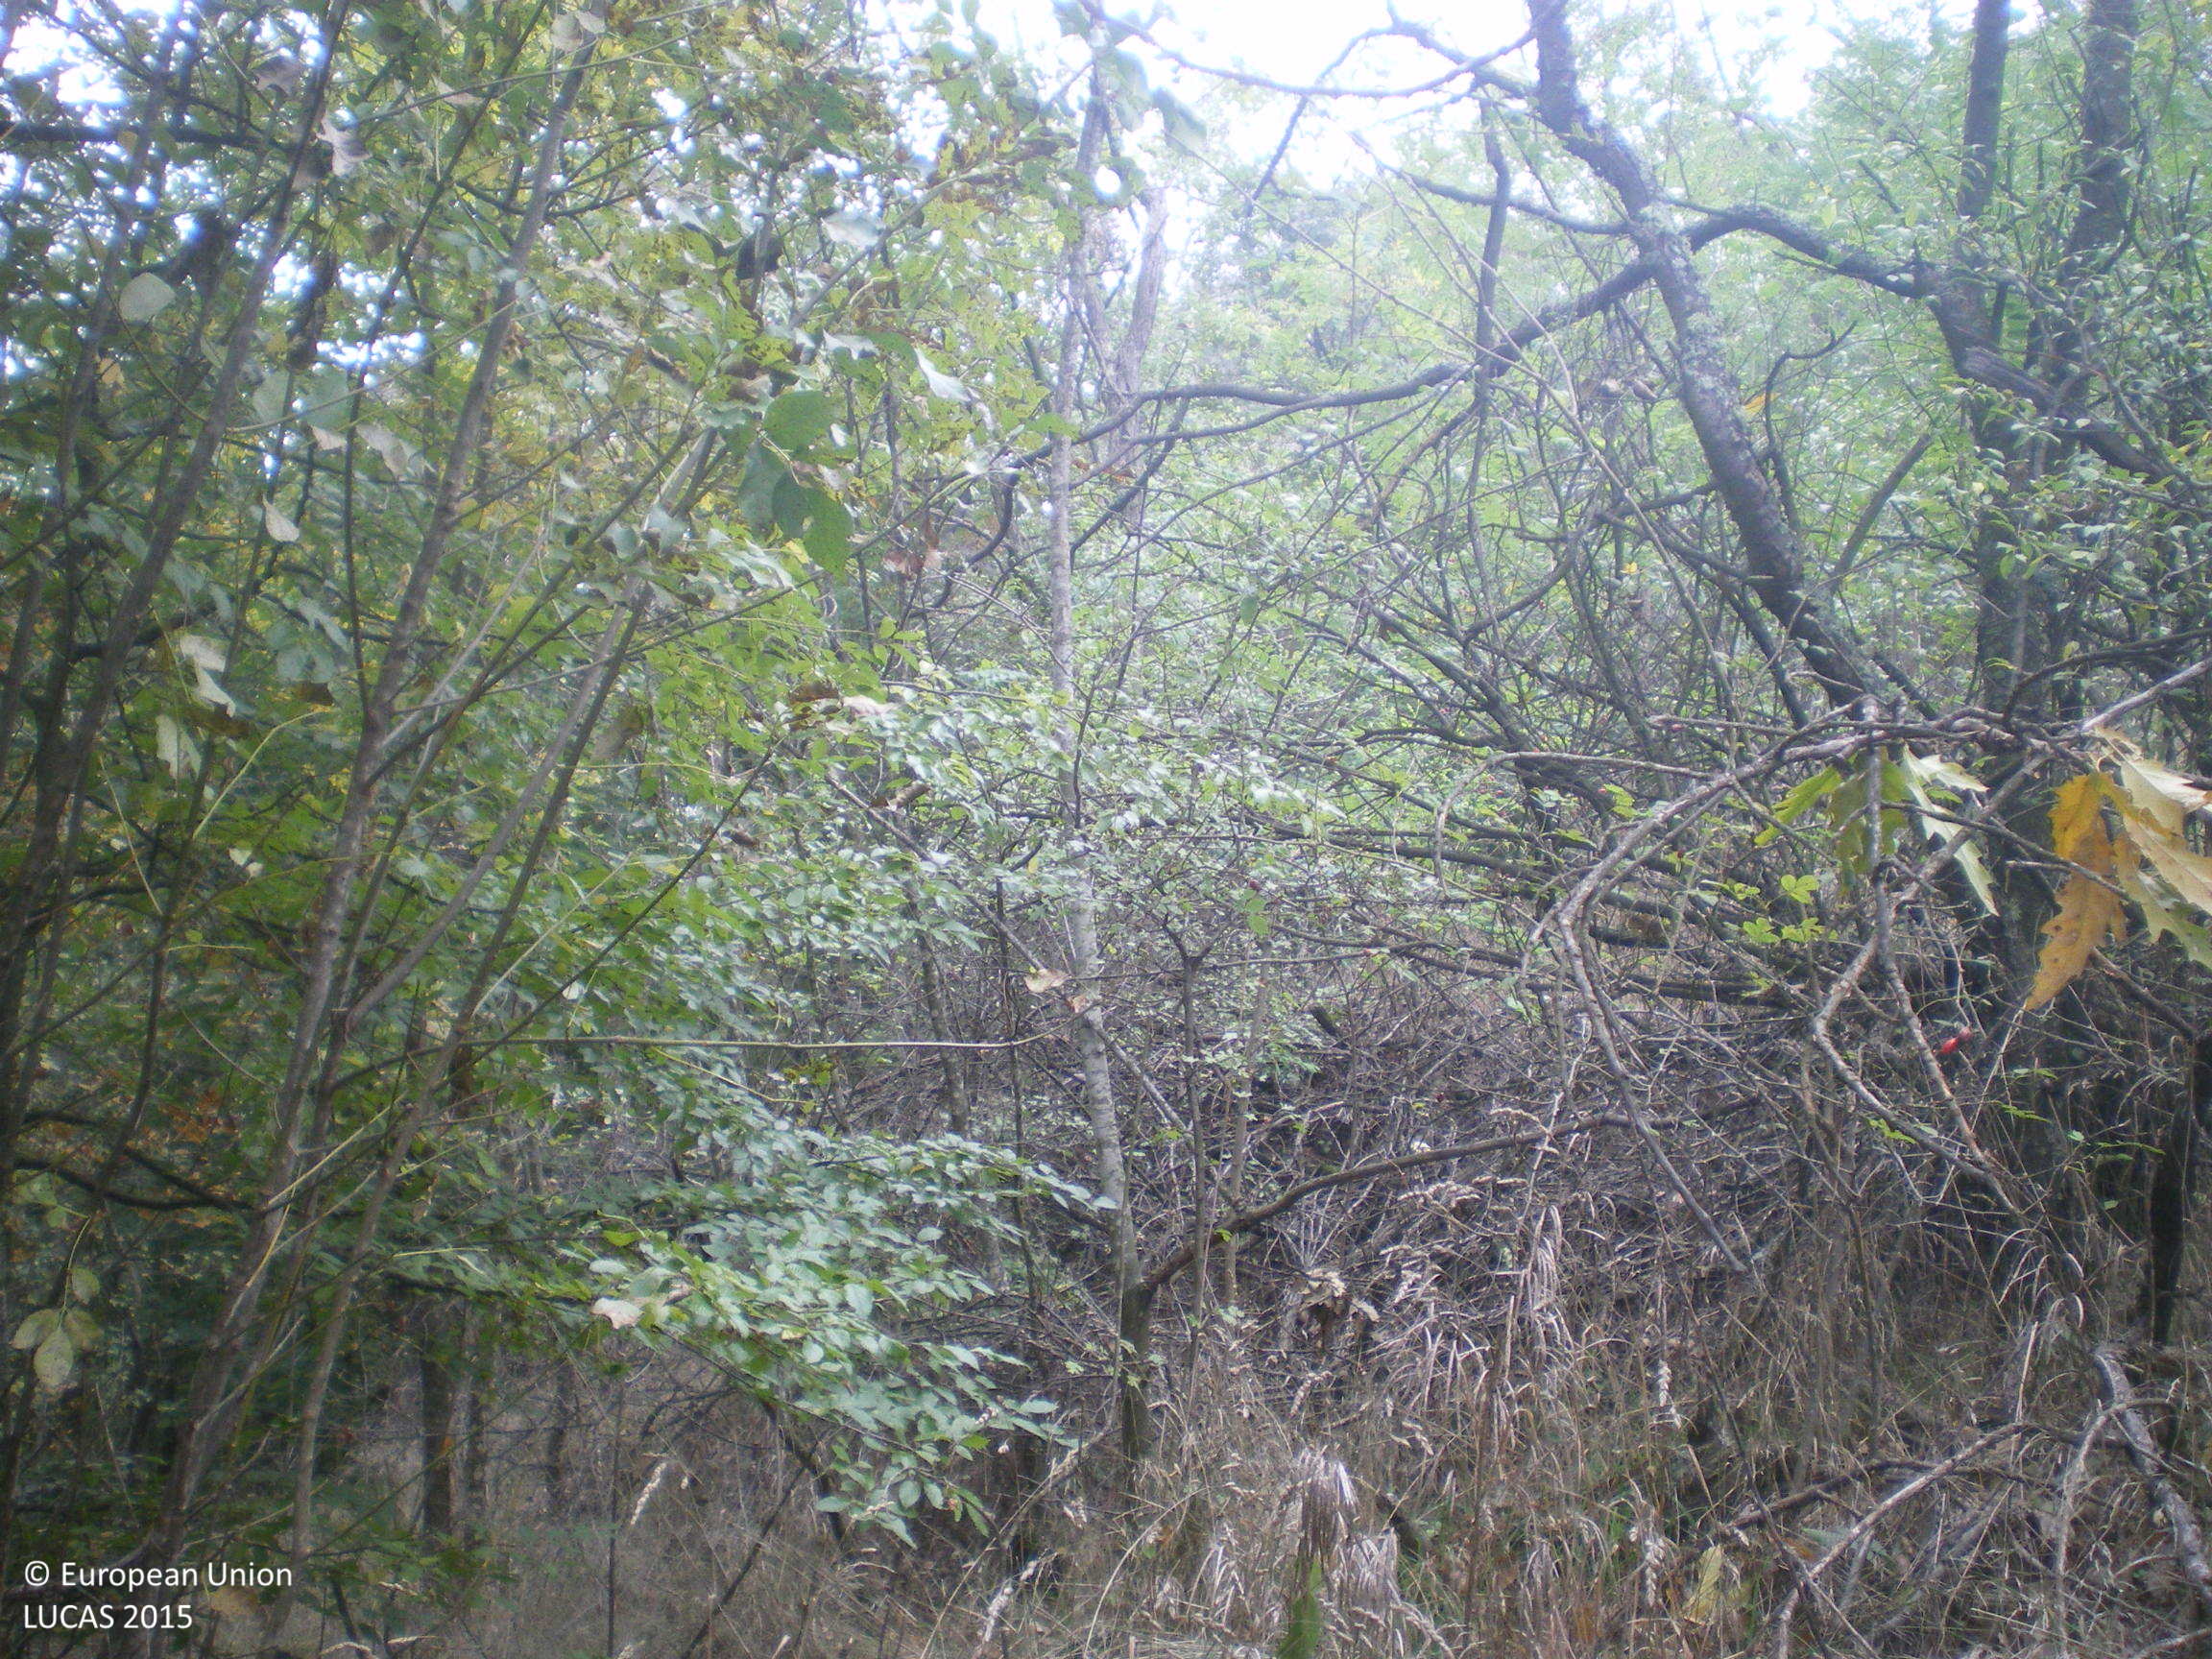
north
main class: Woodland
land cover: Other mixed woodland
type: hemiboreal forest and nemoral coniferous forest and mixed broadleaved-coniferous forest
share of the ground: > 75 %
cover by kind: coniferous forest trees 65 %, broadleaved forest trees 25 %, shrubs 10 %
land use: Forestry
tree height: > 5 m
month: October
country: BG
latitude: 42.6758
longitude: 25.6585
